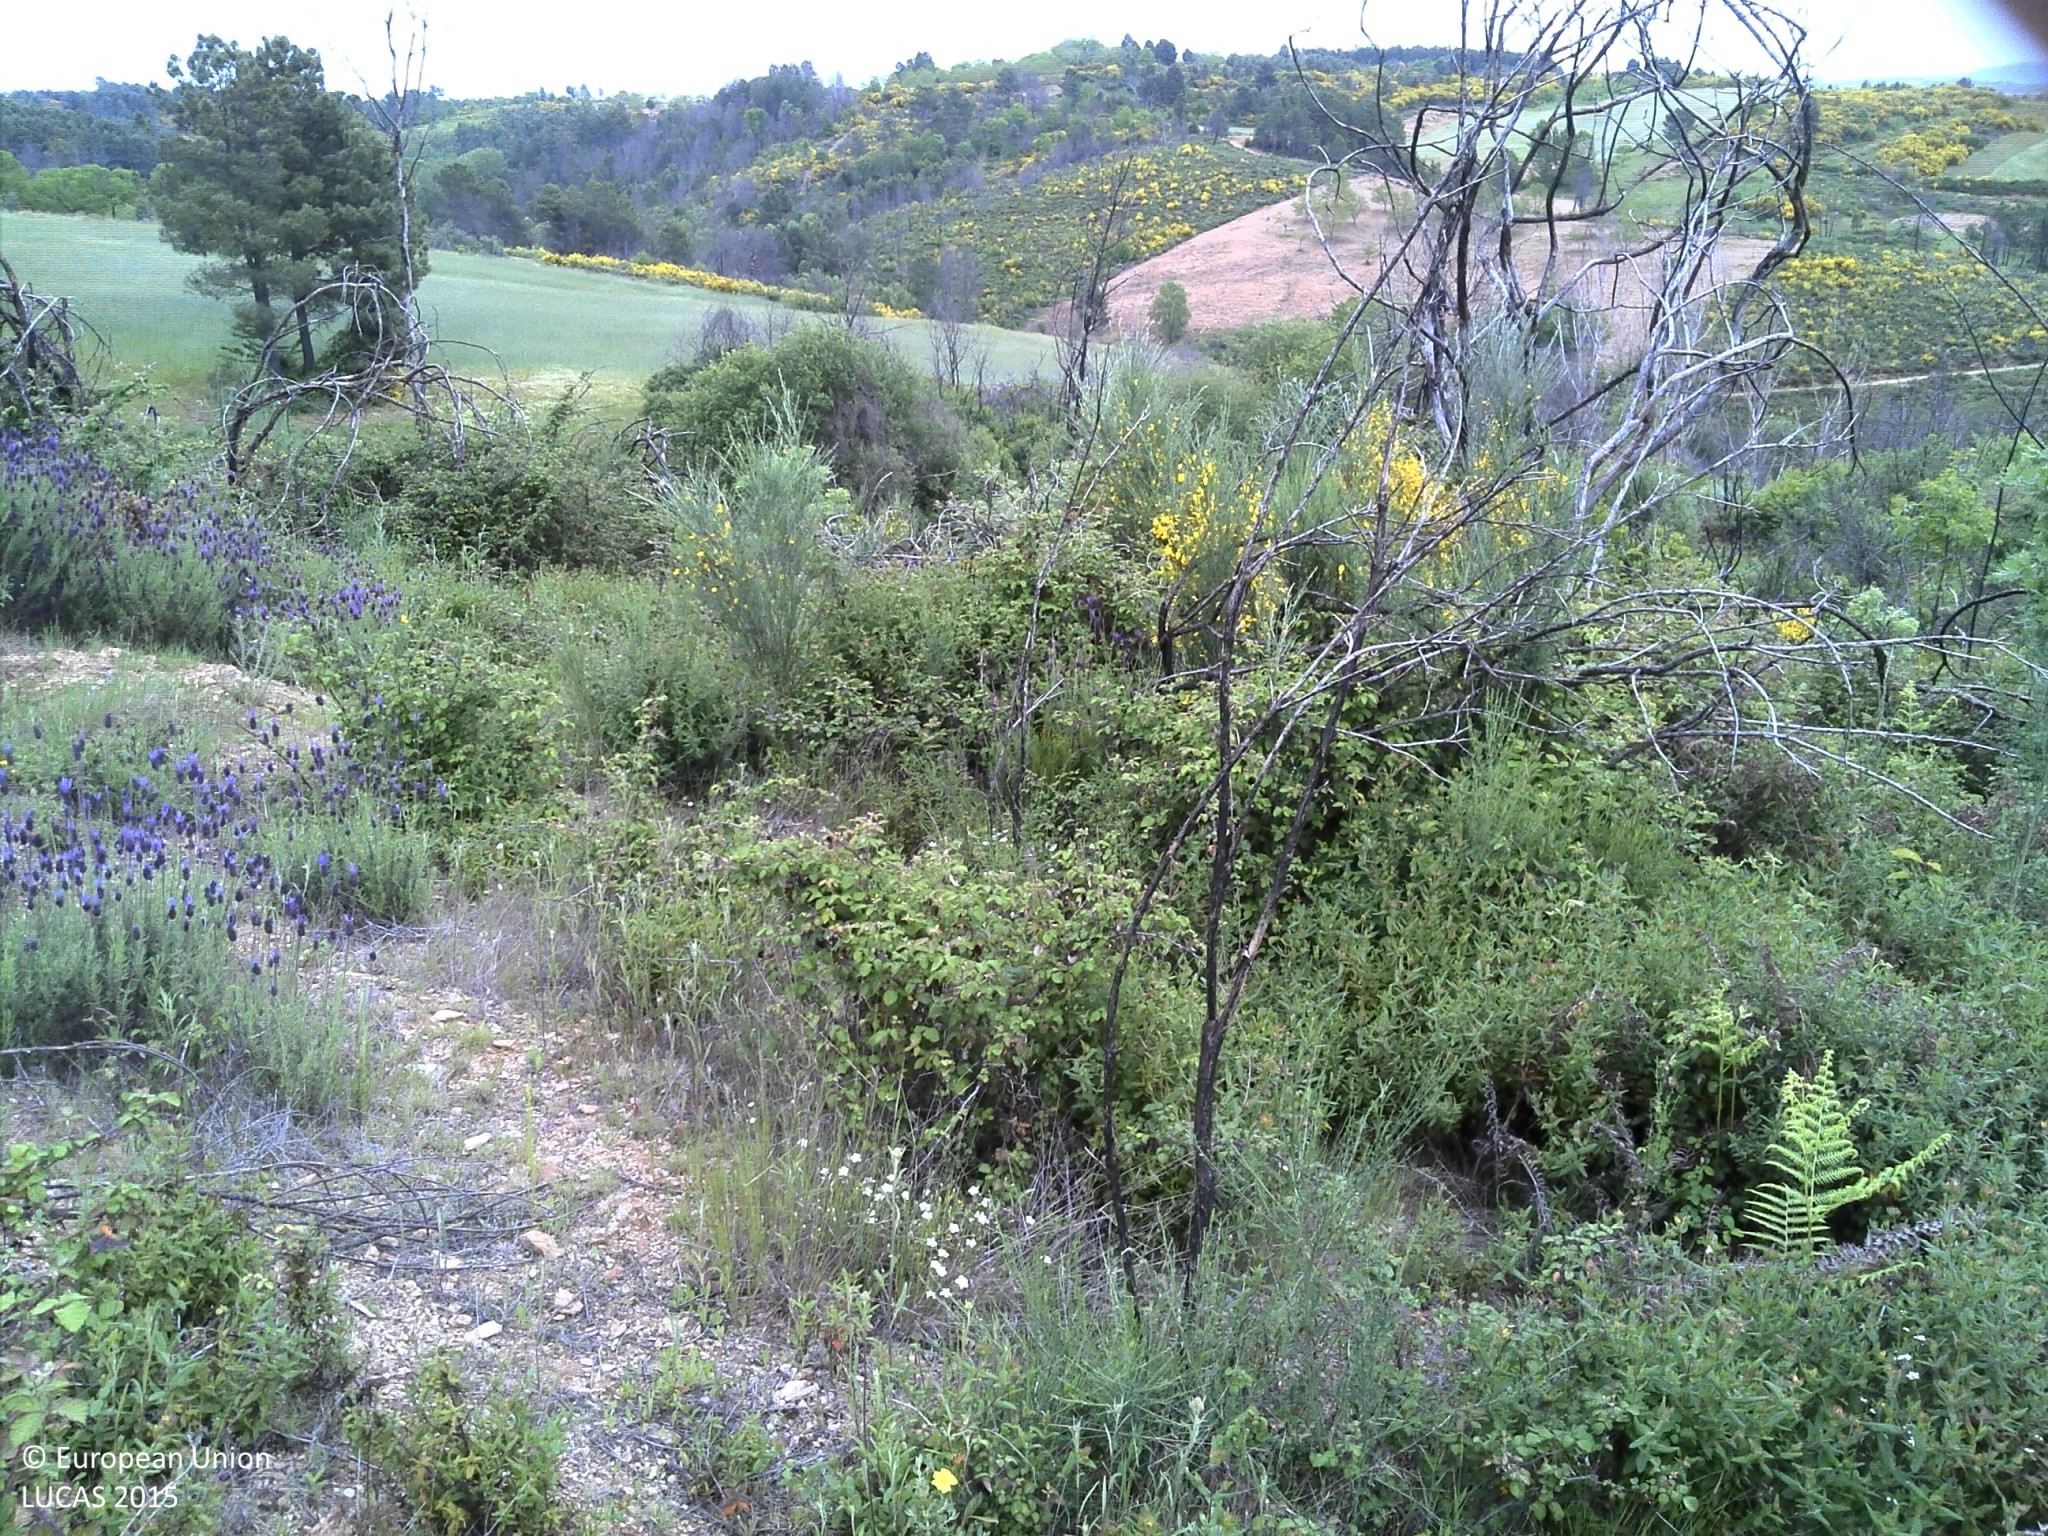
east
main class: Shrubland
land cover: Shrubland with sparse tree cover
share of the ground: 25 - 50 %
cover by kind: shrubs 50 %, unconsolidated bare surface 40 %, broadleaved forest trees 5 %, herbaceous plants 5 %
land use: Forestry
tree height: < 5 m
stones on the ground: 10 - 25 %
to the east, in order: Shrubland with sparse tree cover; Spontaneously vegetated surfaces; Shrubland with sparse tree cover; Spontaneously vegetated surfaces; Shrubland with sparse tree cover; Rye; Spontaneously vegetated surfaces; Rye
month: May
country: PT
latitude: 41.7947
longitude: -7.1017
